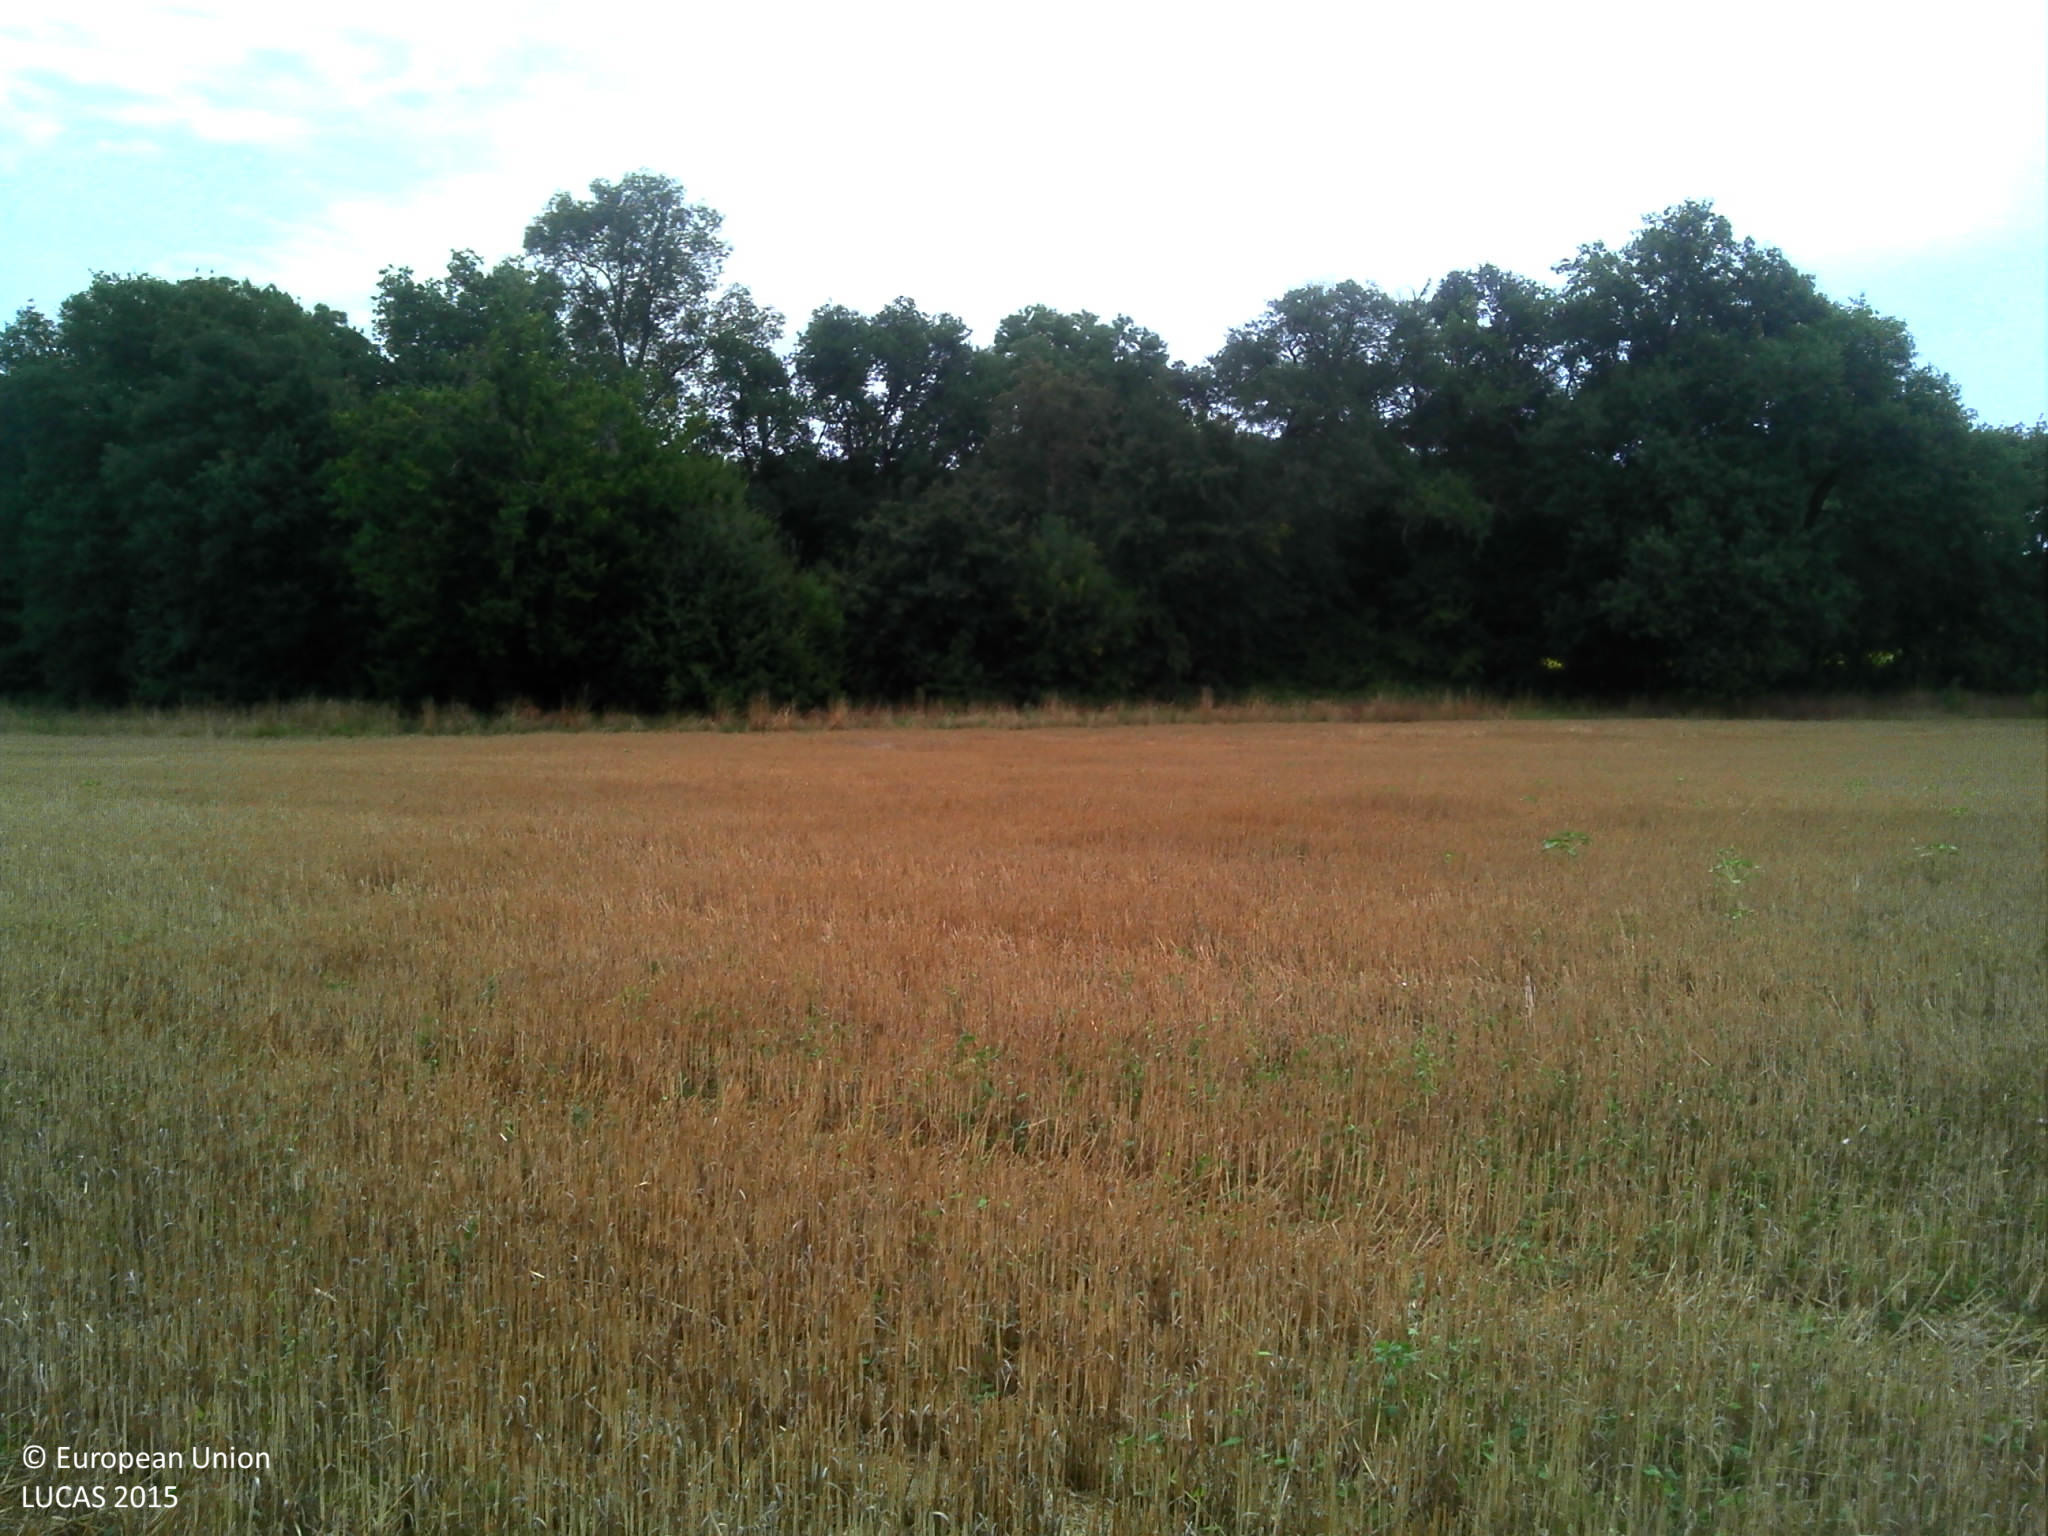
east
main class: Cropland
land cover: Common wheat
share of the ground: > 75 %
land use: Agriculture (excluding fallow land and kitchen gardens)
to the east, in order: Common wheat; Spontaneously vegetated surfaces; Broadleaved woodland; Rivers and streams; Broadleaved woodland; Rivers and streams; Broadleaved woodland; Grassland without tree/shrub cover; Fences; Broadleaved woodland; Electric lines; Grass margins; Paved roads, cycling and walking lanes; Grass margins; Abandoned hedges; Grassland without tree/shrub cover; Broadleaved woodland; Common wheat
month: July
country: FR
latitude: 44.0767
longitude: 0.6931
